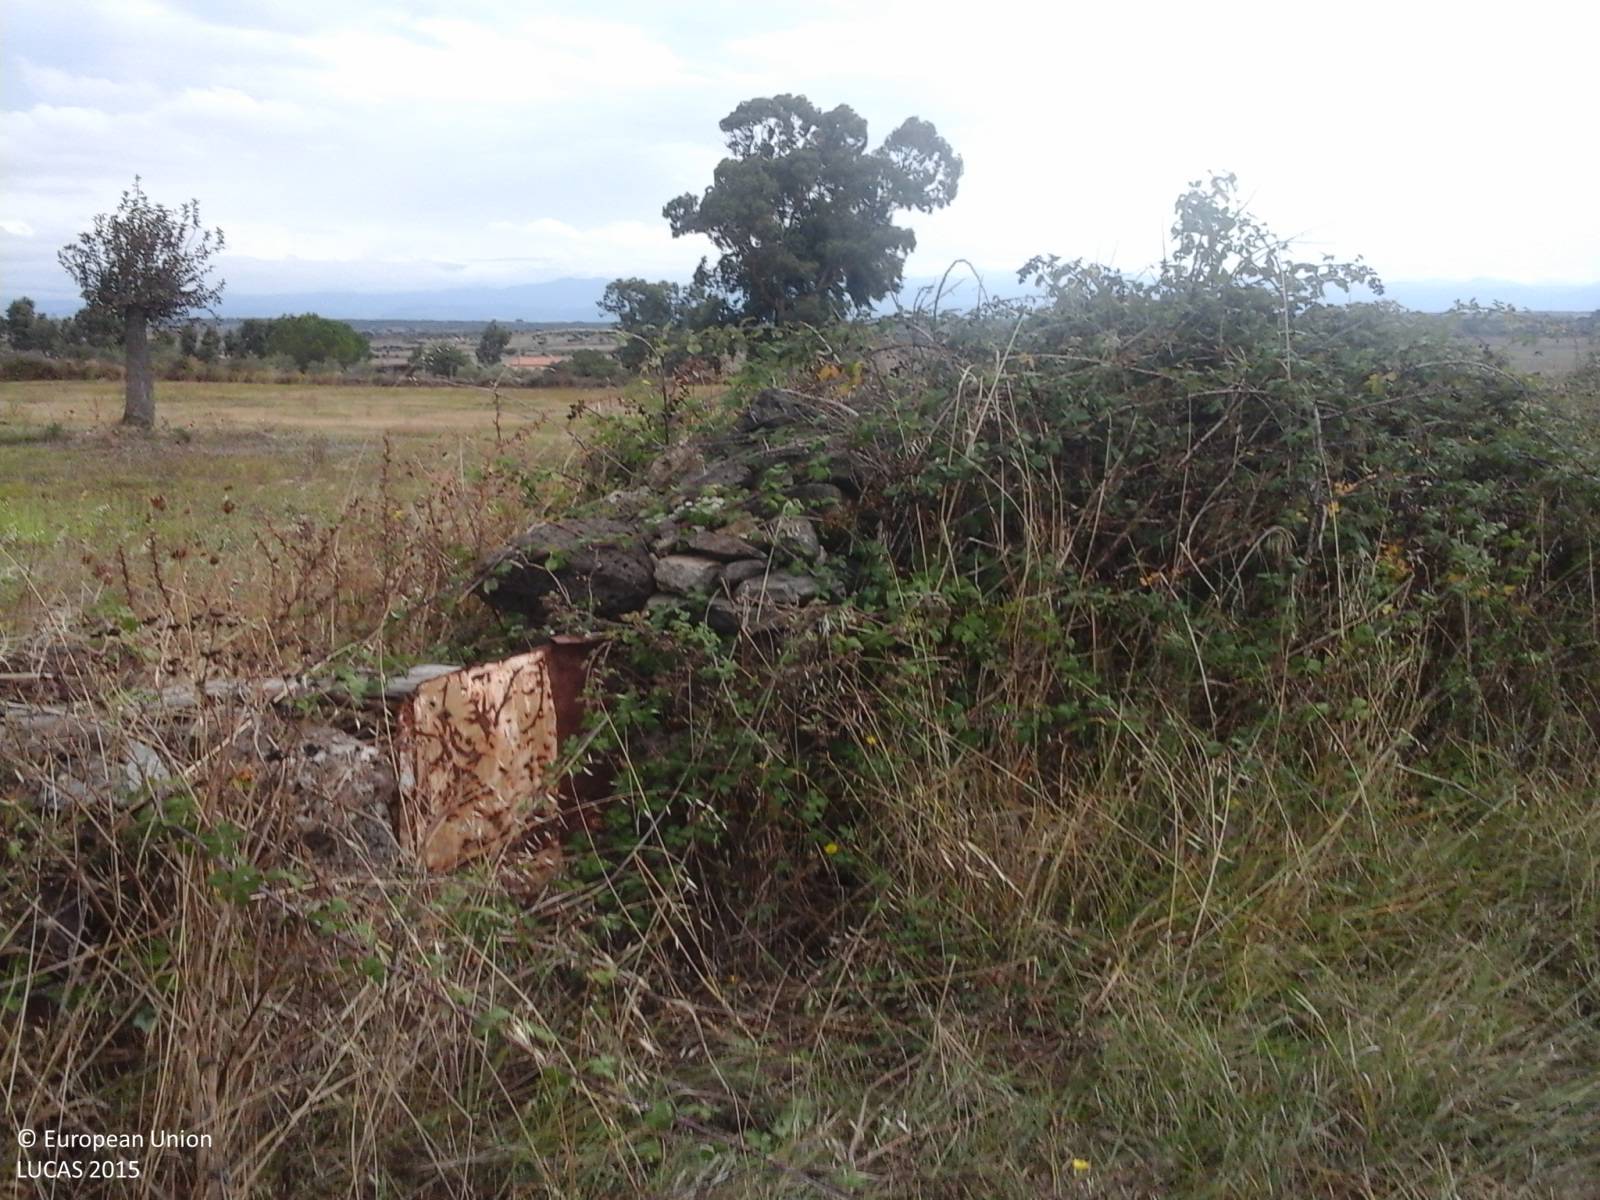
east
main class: Grassland
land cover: Grassland without tree/shrub cover
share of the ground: > 75 %
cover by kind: herbaceous plants 100 %
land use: Agriculture (excluding fallow land and kitchen gardens)
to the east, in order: Grassland without tree/shrub cover; Abandoned hedges; Dry stone walls; Olive groves; Dry stone walls; Lines of trees; Temporary grasslands; Fences; Dry stone walls; Lines of trees; Grassland without tree/shrub cover; Lines of trees; Dry stone walls; Fences; Paved roads, cycling and walking lanes; Fences; Grassland without tree/shrub cover
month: September
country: IT
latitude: 40.2602
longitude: 8.8186
